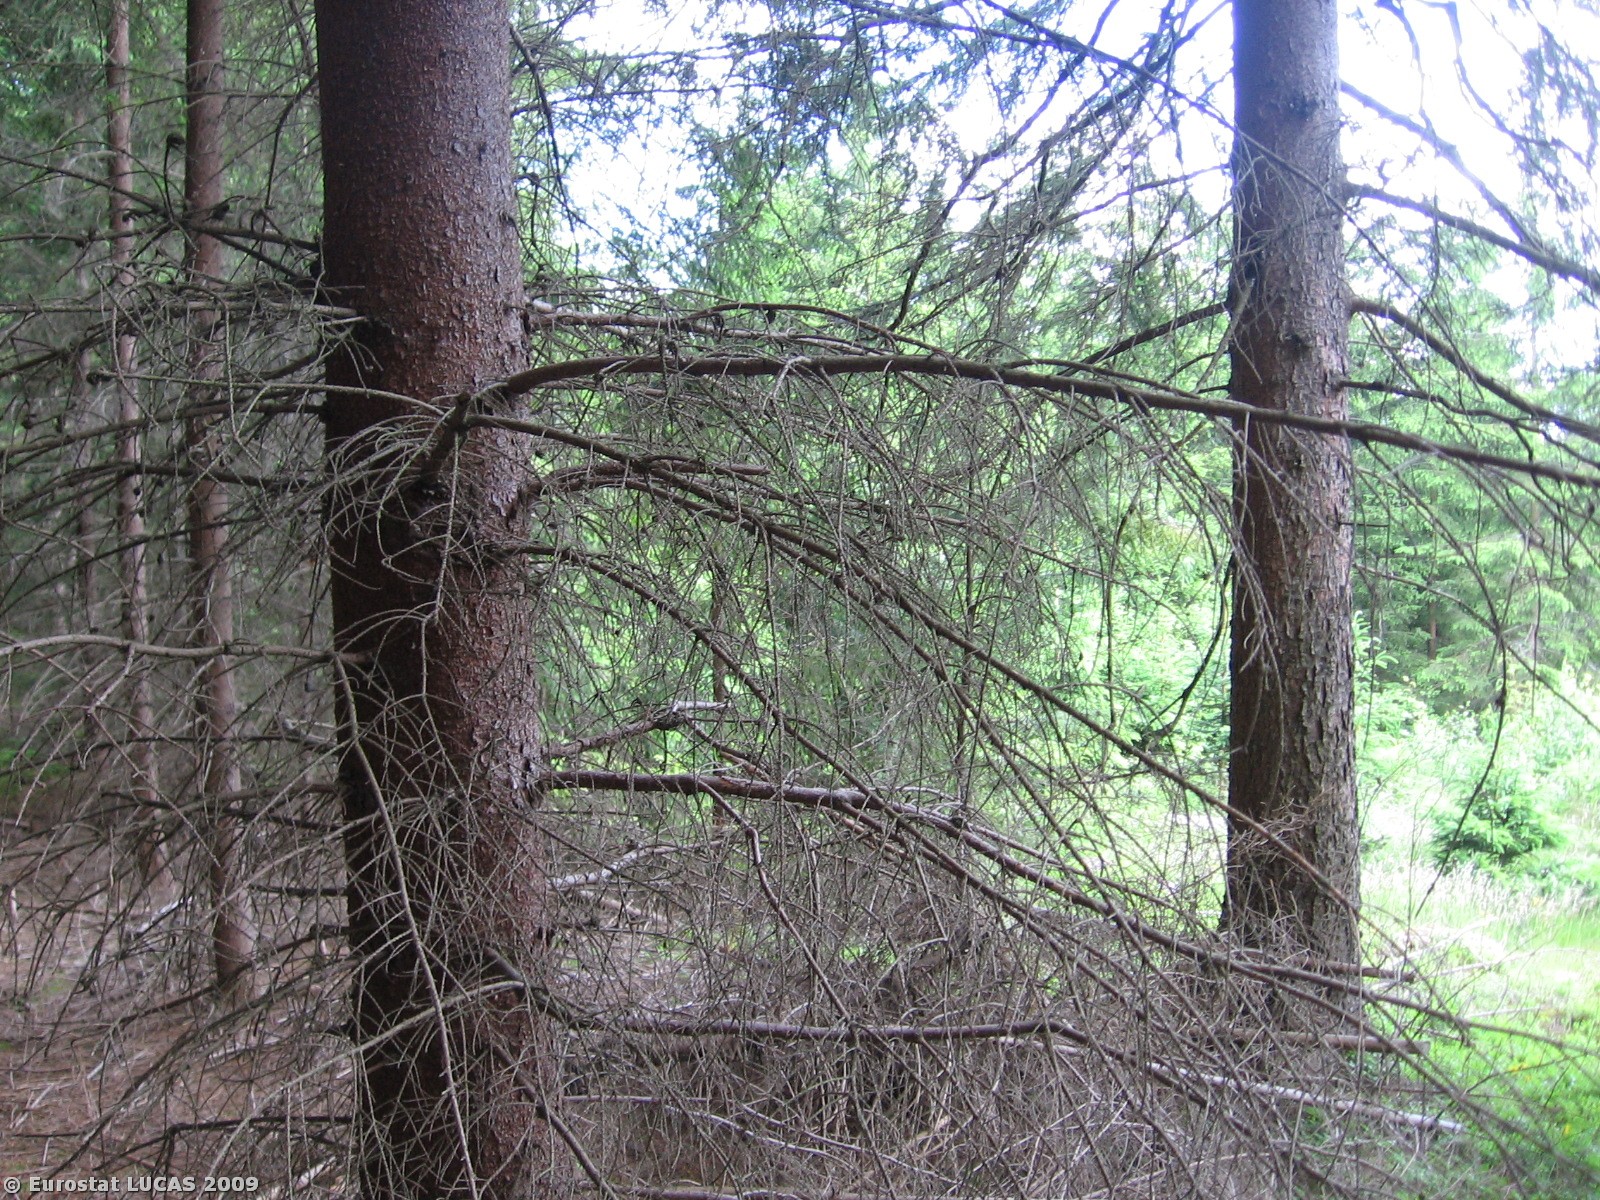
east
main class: Woodland
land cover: Coniferous woodland
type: hemiboreal forest and nemoral coniferous forest and mixed broadleaved-coniferous forest
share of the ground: > 75 %
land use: Forestry
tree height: > 5 m
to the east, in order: Coniferous woodland; Tracks; Coniferous woodland; Tracks; Coniferous woodland; Broadleaved woodland; Grassland without tree/shrub cover; Paved roads, cycling and walking lanes; Grassland without tree/shrub cover
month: June
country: CZ
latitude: 49.0571
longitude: 13.8456
